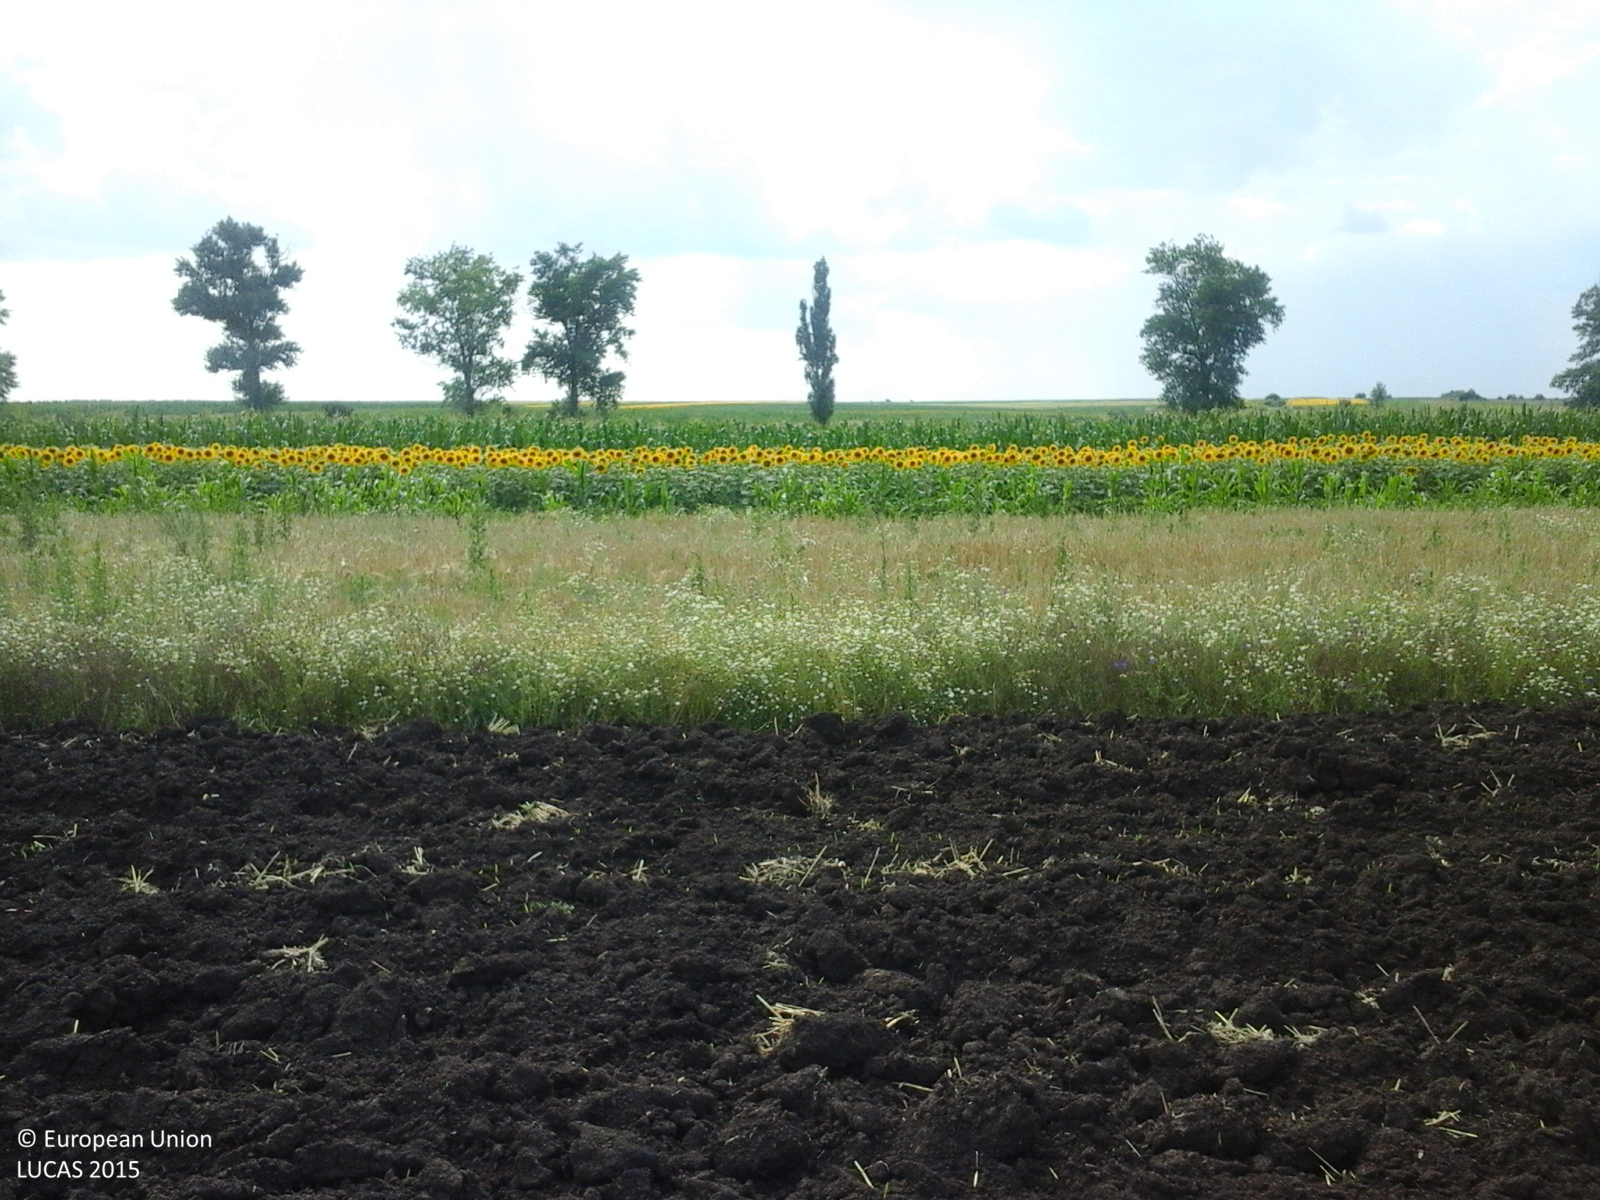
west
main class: Cropland
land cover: Common wheat
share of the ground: < 10 %
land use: Agriculture (excluding fallow land and kitchen gardens)
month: July
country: RO
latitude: 44.0159
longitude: 25.7732
